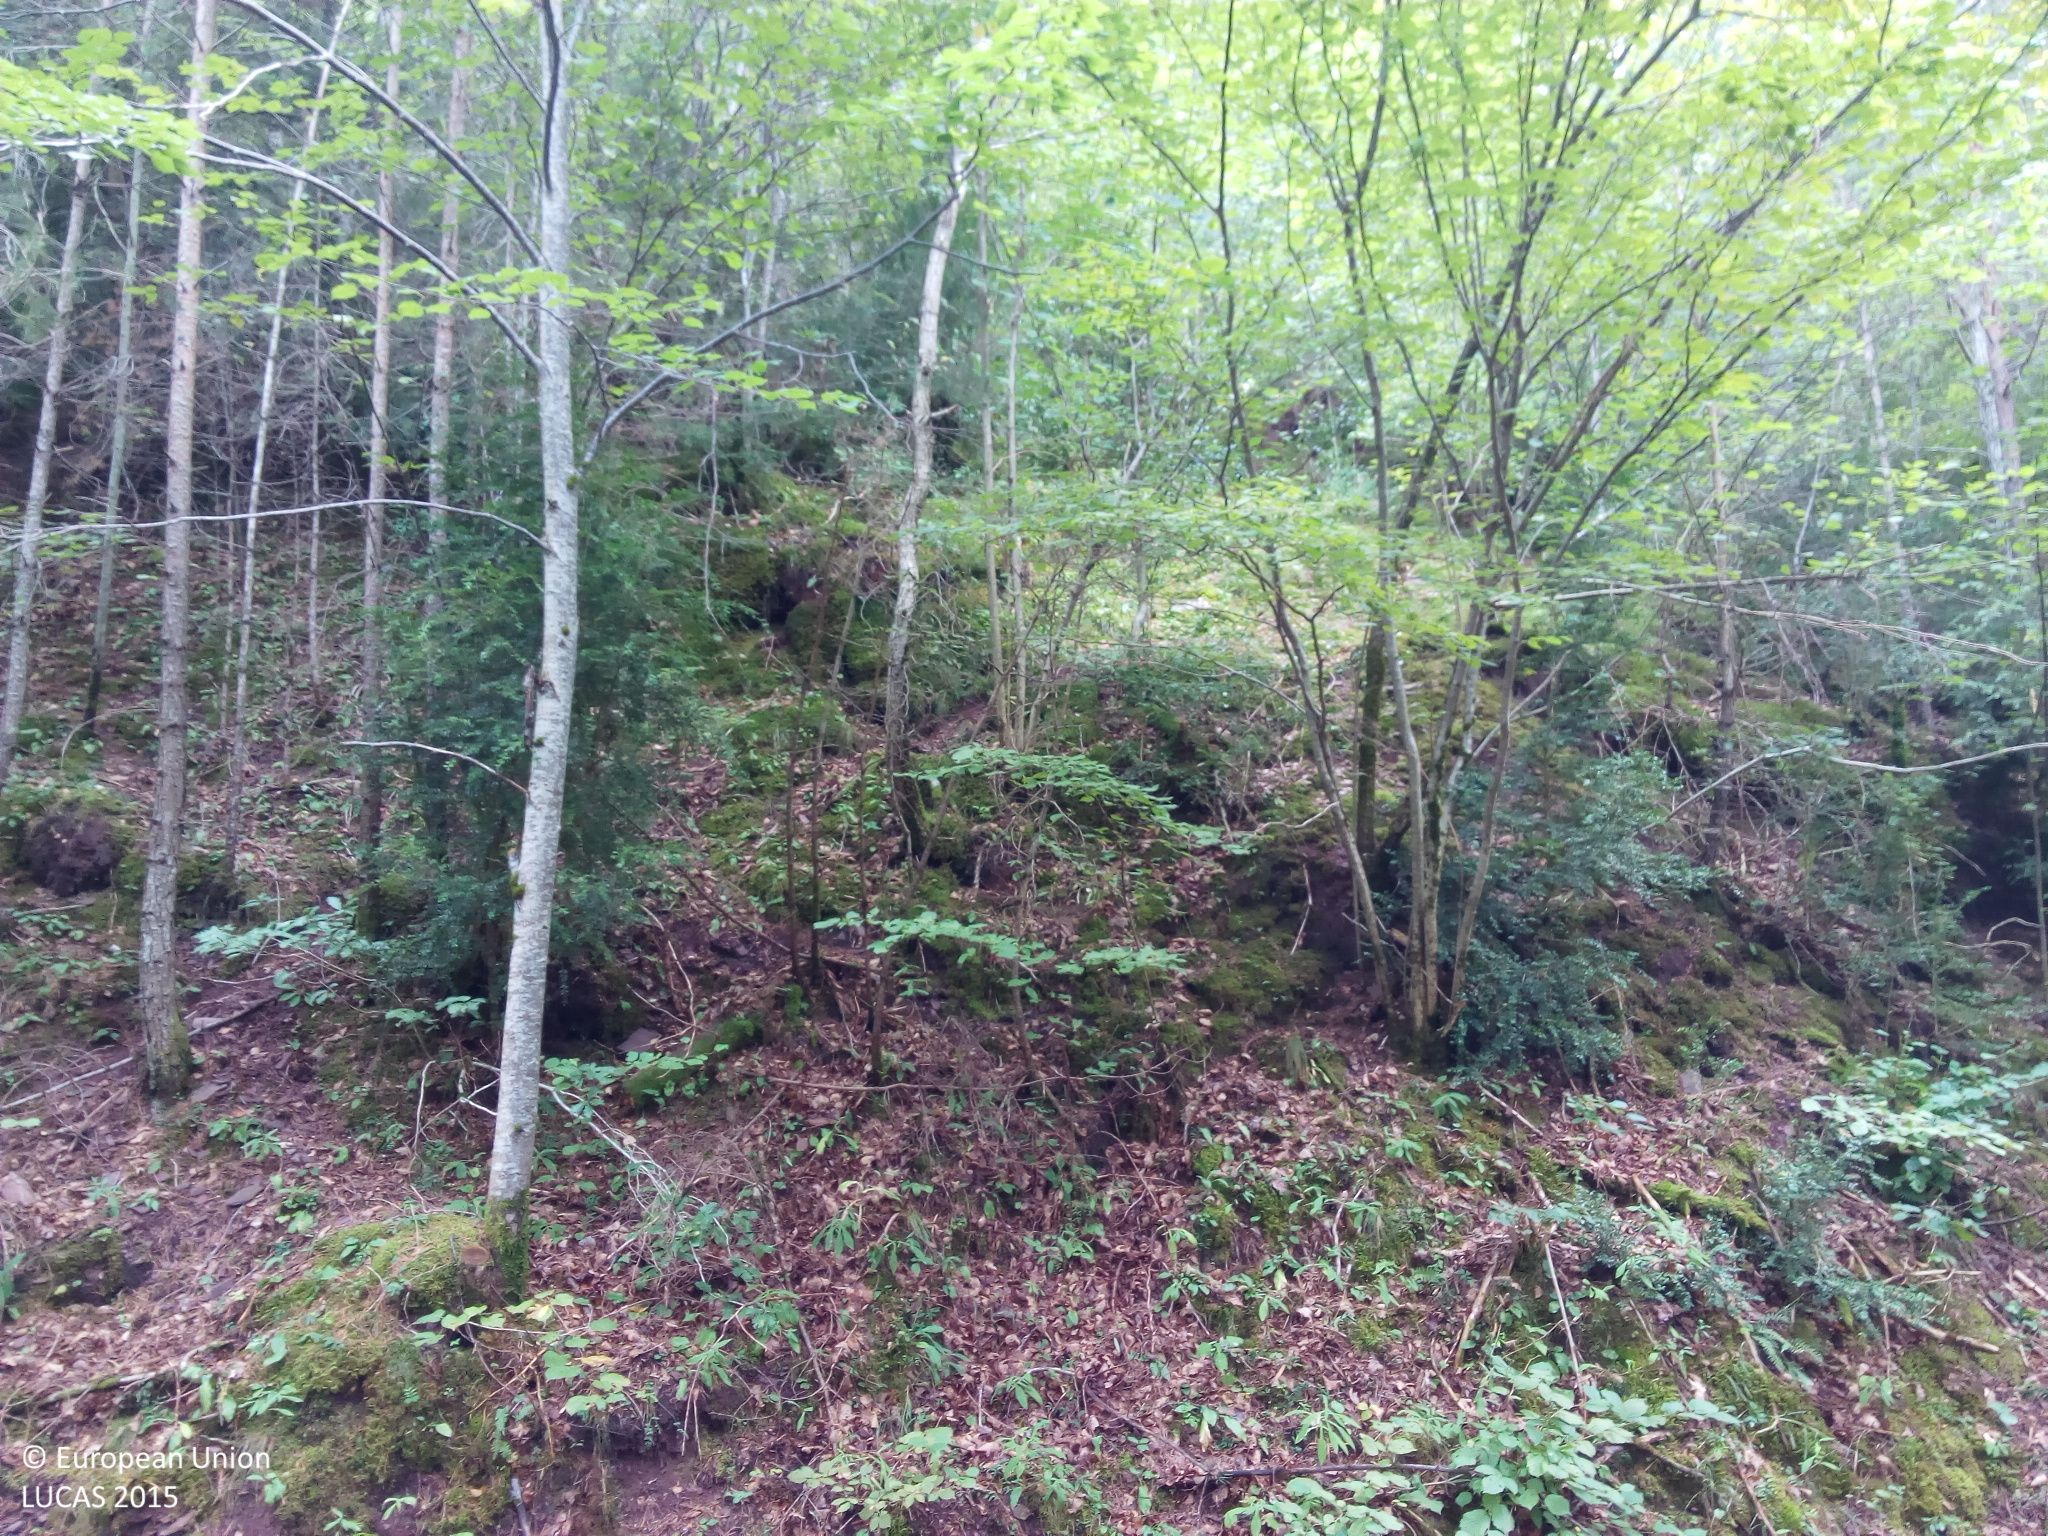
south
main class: Woodland
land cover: Pine dominated mixed woodland
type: alpine coniferous forest
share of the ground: > 75 %
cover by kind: coniferous forest trees 55 %, broadleaved forest trees 45 %
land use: Semi-natural and natural areas not in use
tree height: > 5 m
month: September
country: ES
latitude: 42.6176
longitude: 0.2370
